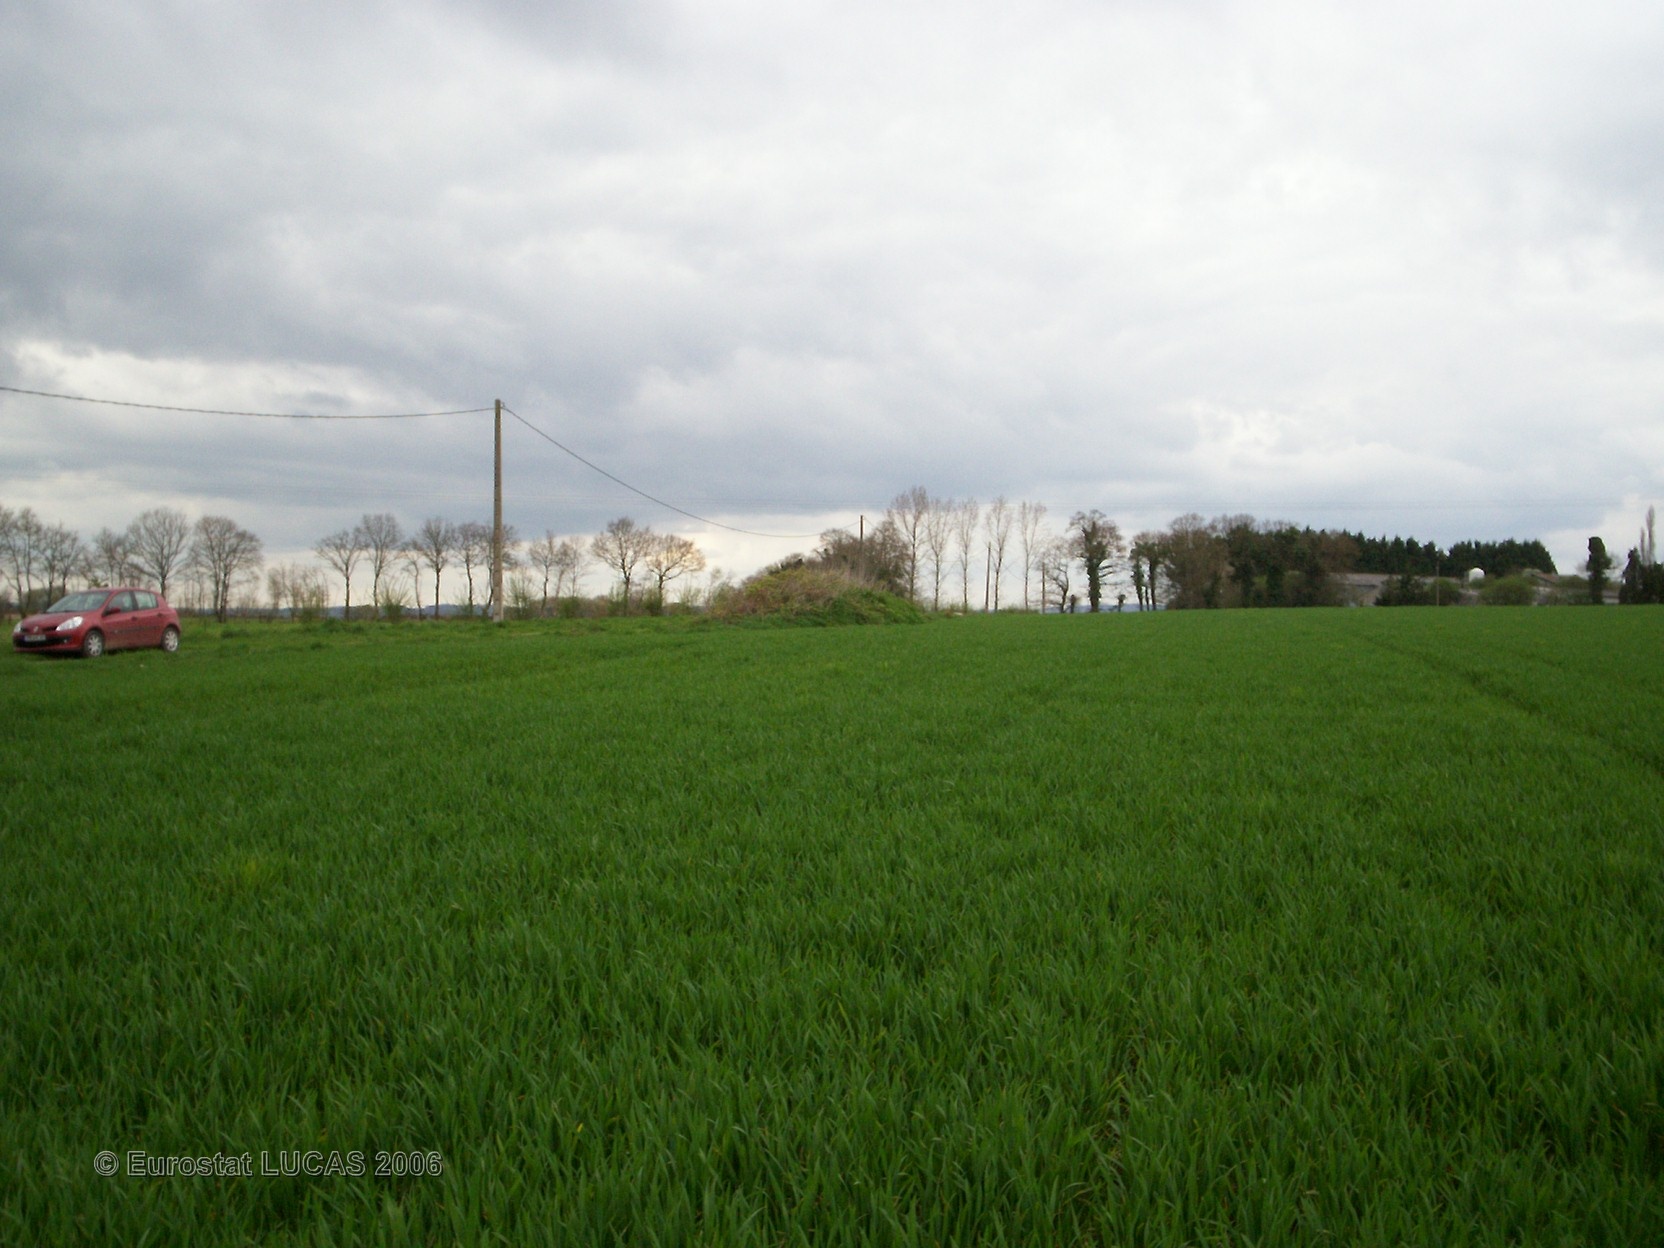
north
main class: Cropland
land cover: Common wheat
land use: Agriculture (excluding fallow land and kitchen gardens)
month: April
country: FR
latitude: 48.1536
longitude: -2.9044
